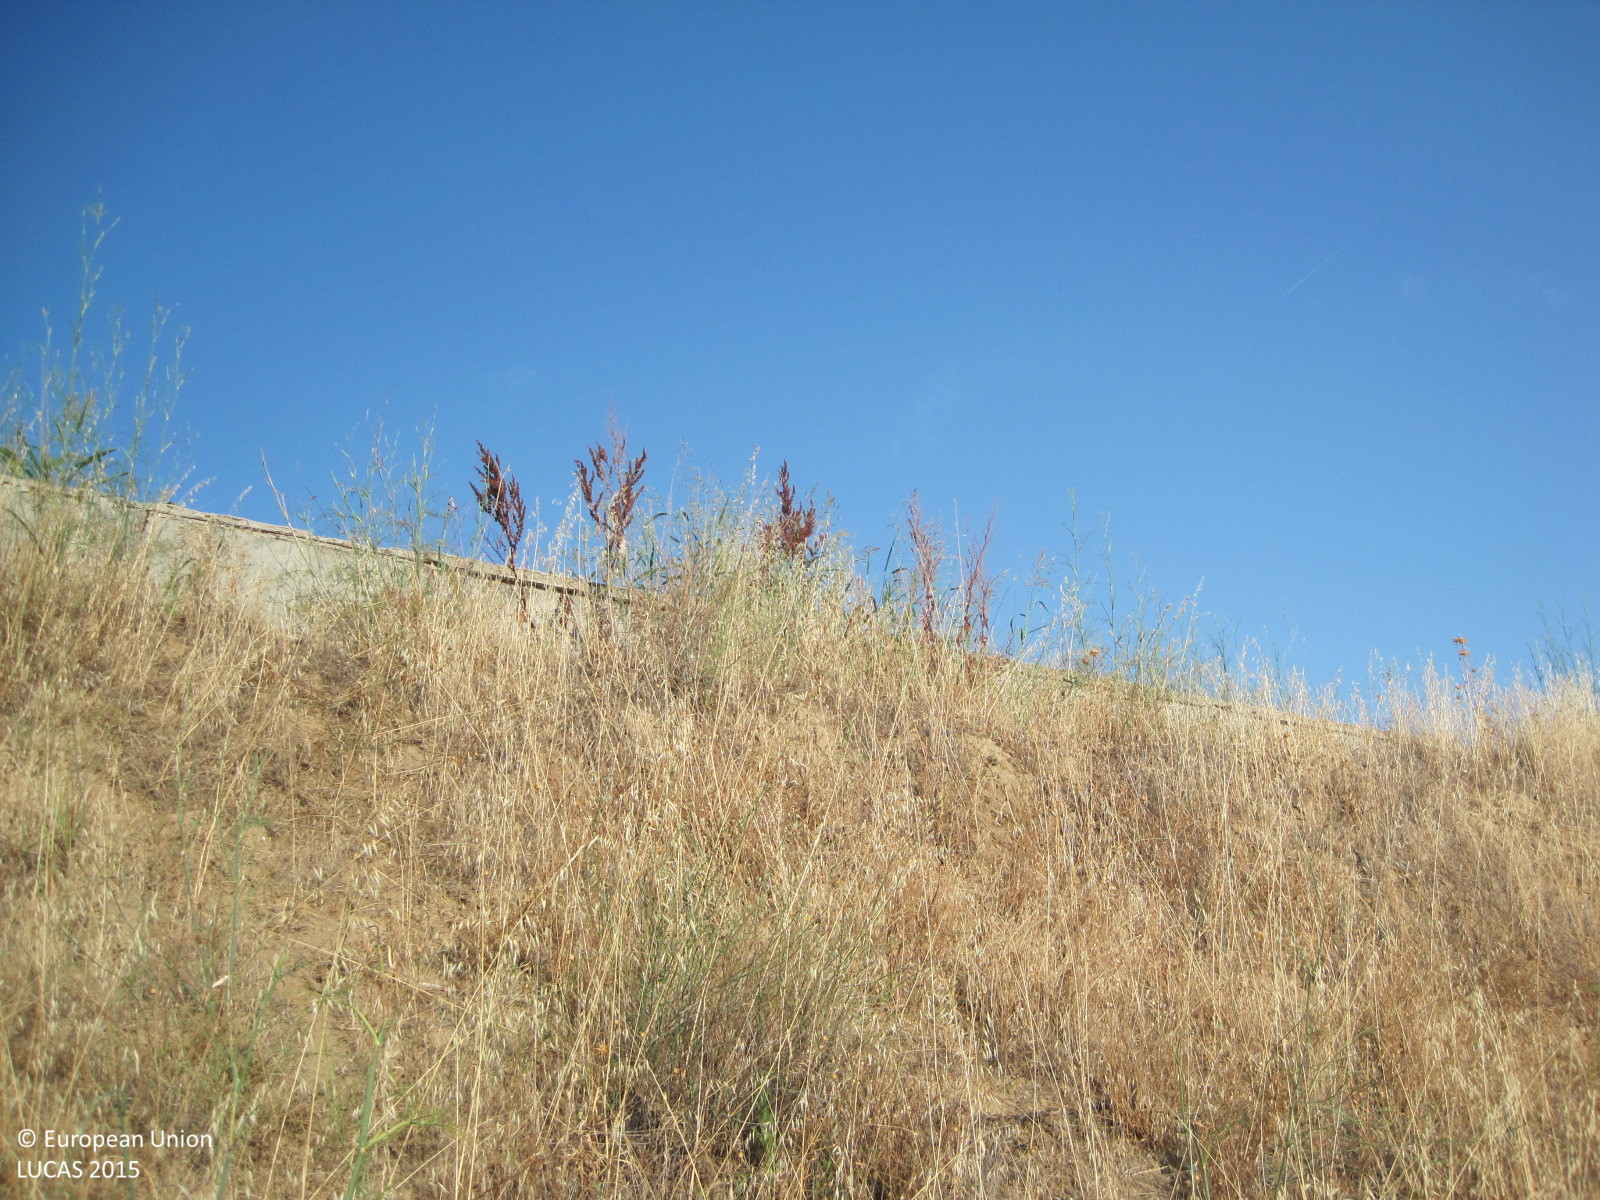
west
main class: Cropland
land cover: Maize
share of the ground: > 75 %
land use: Agriculture (excluding fallow land and kitchen gardens)
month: July
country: ES
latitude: 39.9633
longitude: -3.8121
